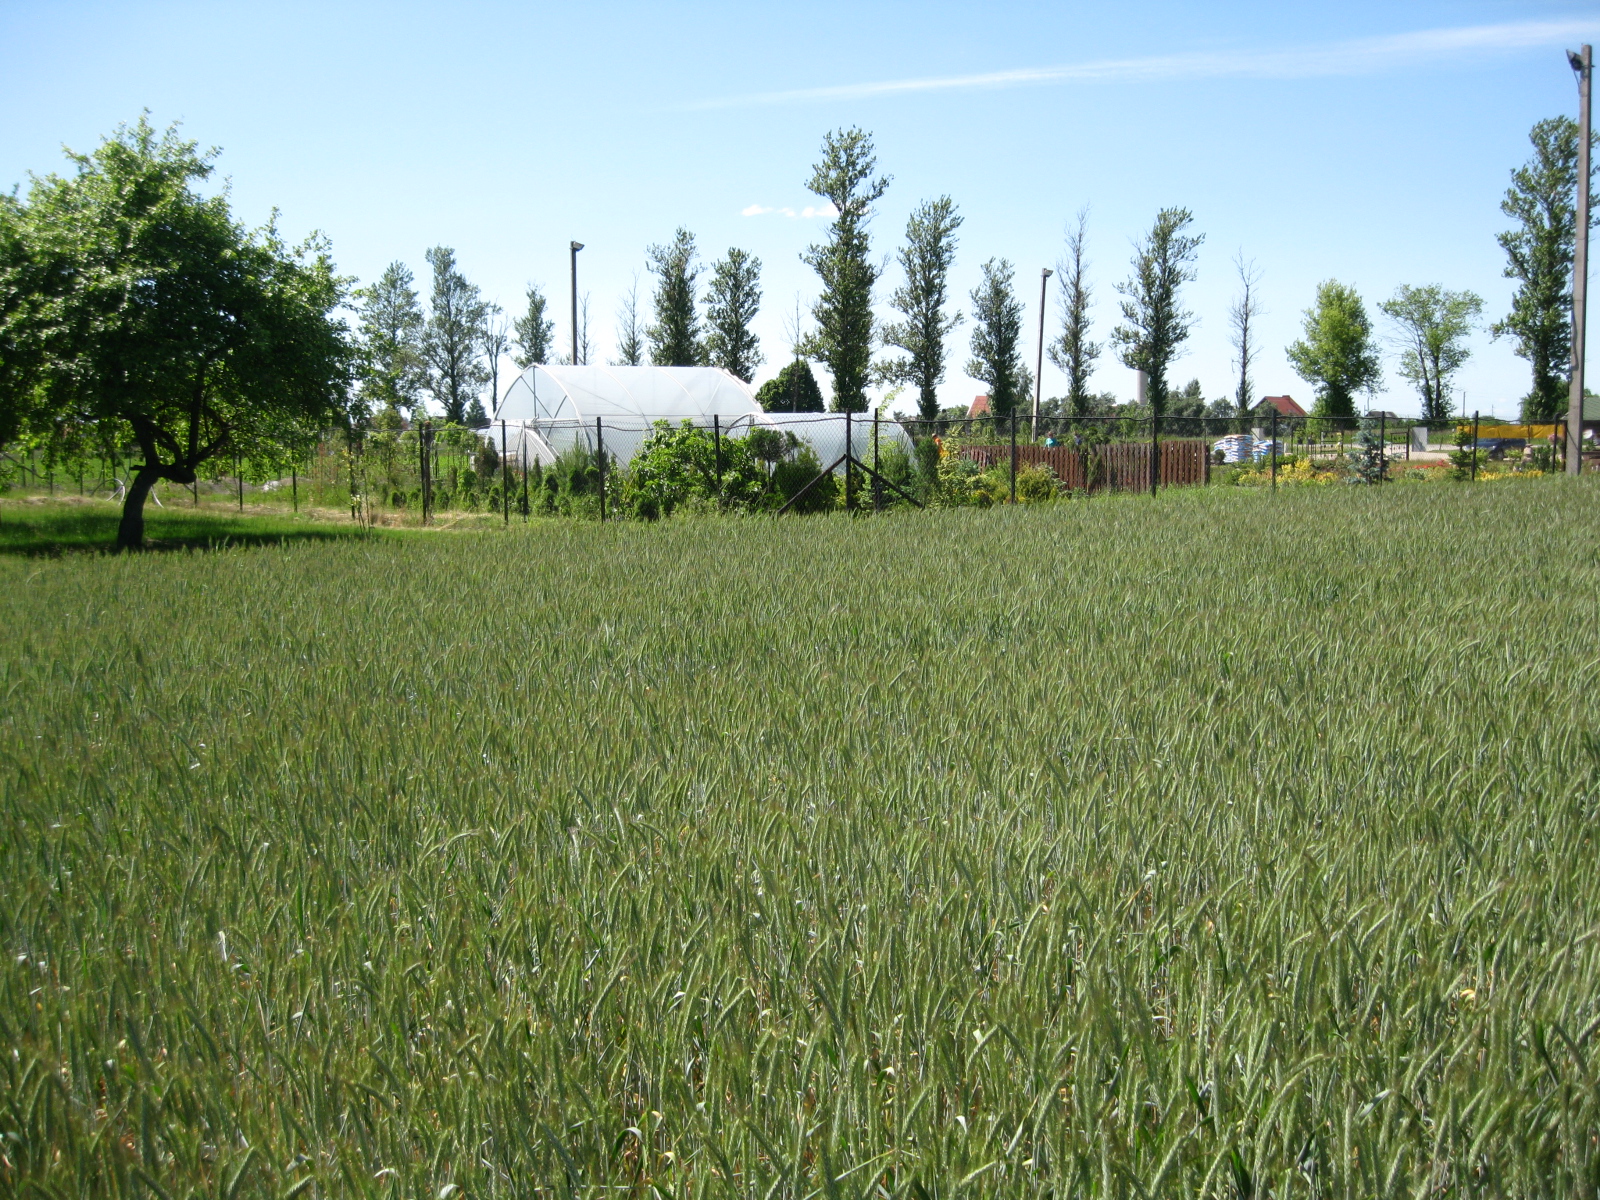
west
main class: Cropland
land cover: Triticale
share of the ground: > 75 %
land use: Agriculture (excluding fallow land and kitchen gardens)
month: June
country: LT
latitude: 55.2488
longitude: 23.8512
